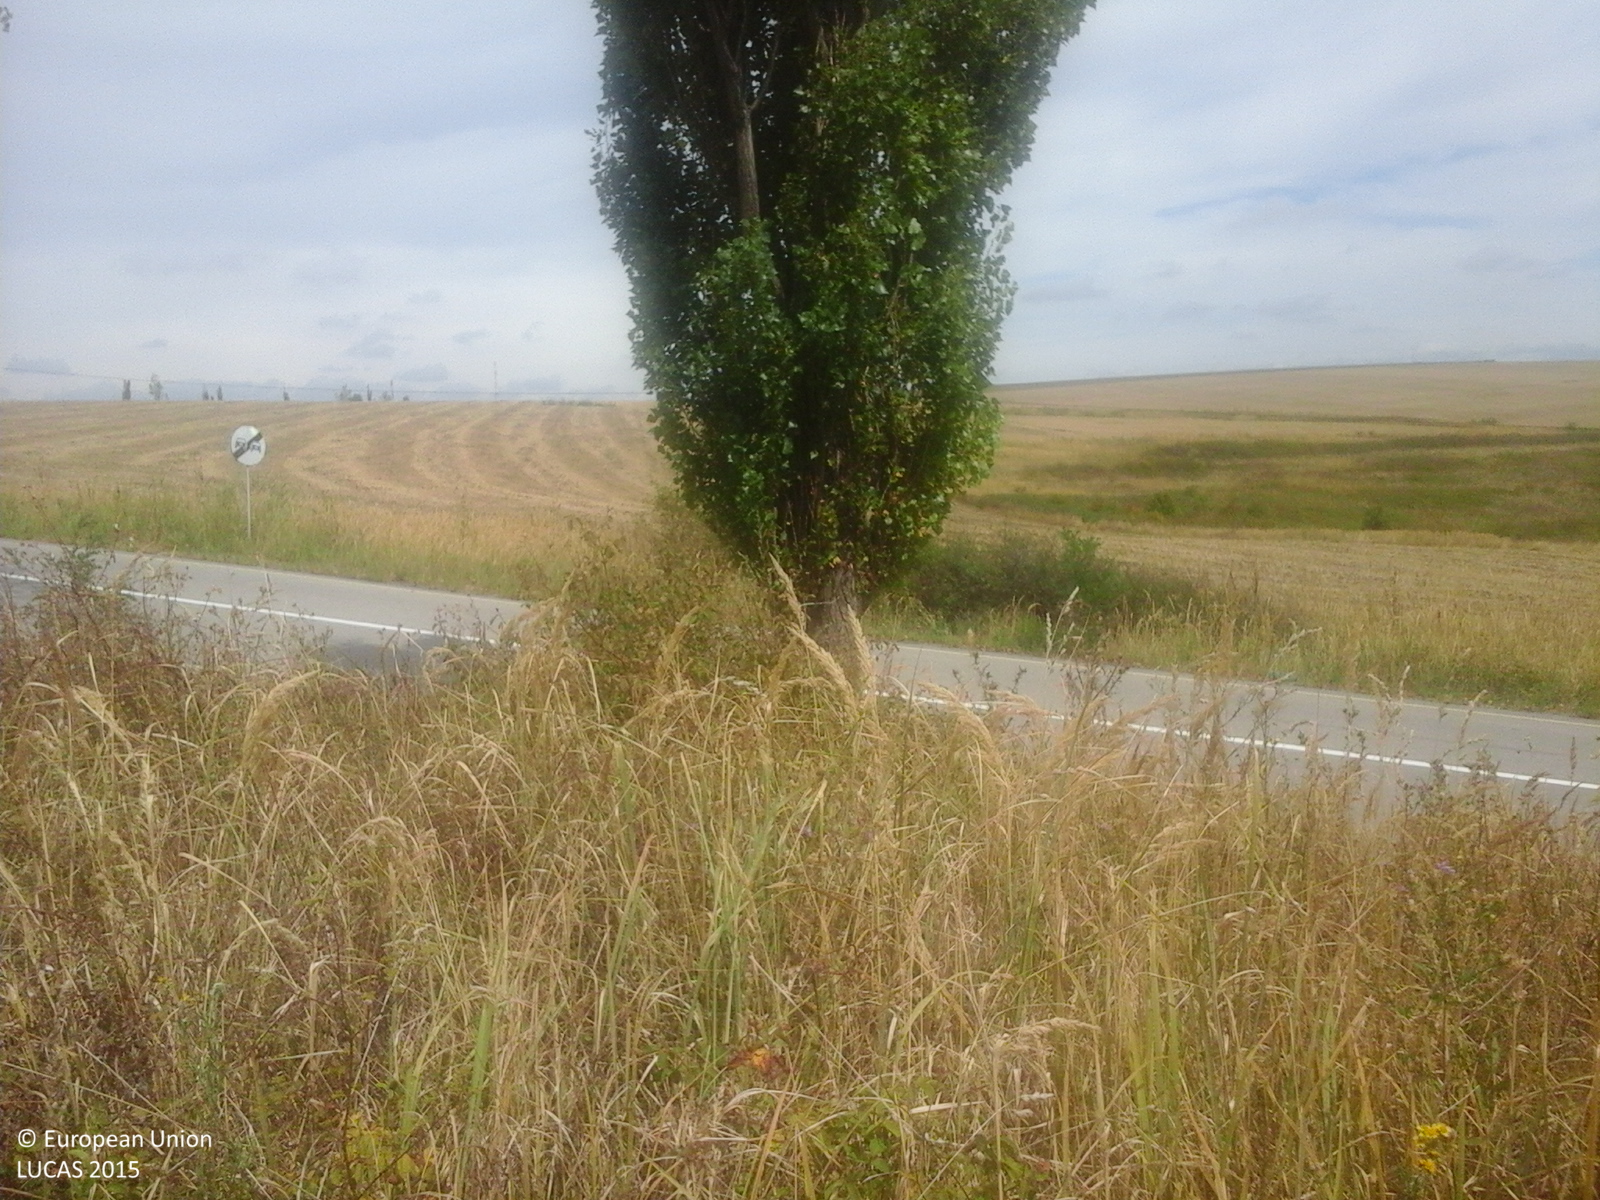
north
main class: Grassland
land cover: Spontaneously vegetated surfaces
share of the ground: > 75 %
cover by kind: herbaceous plants 100 %
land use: Fallow land
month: August
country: RO
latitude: 44.9205
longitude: 21.5704
